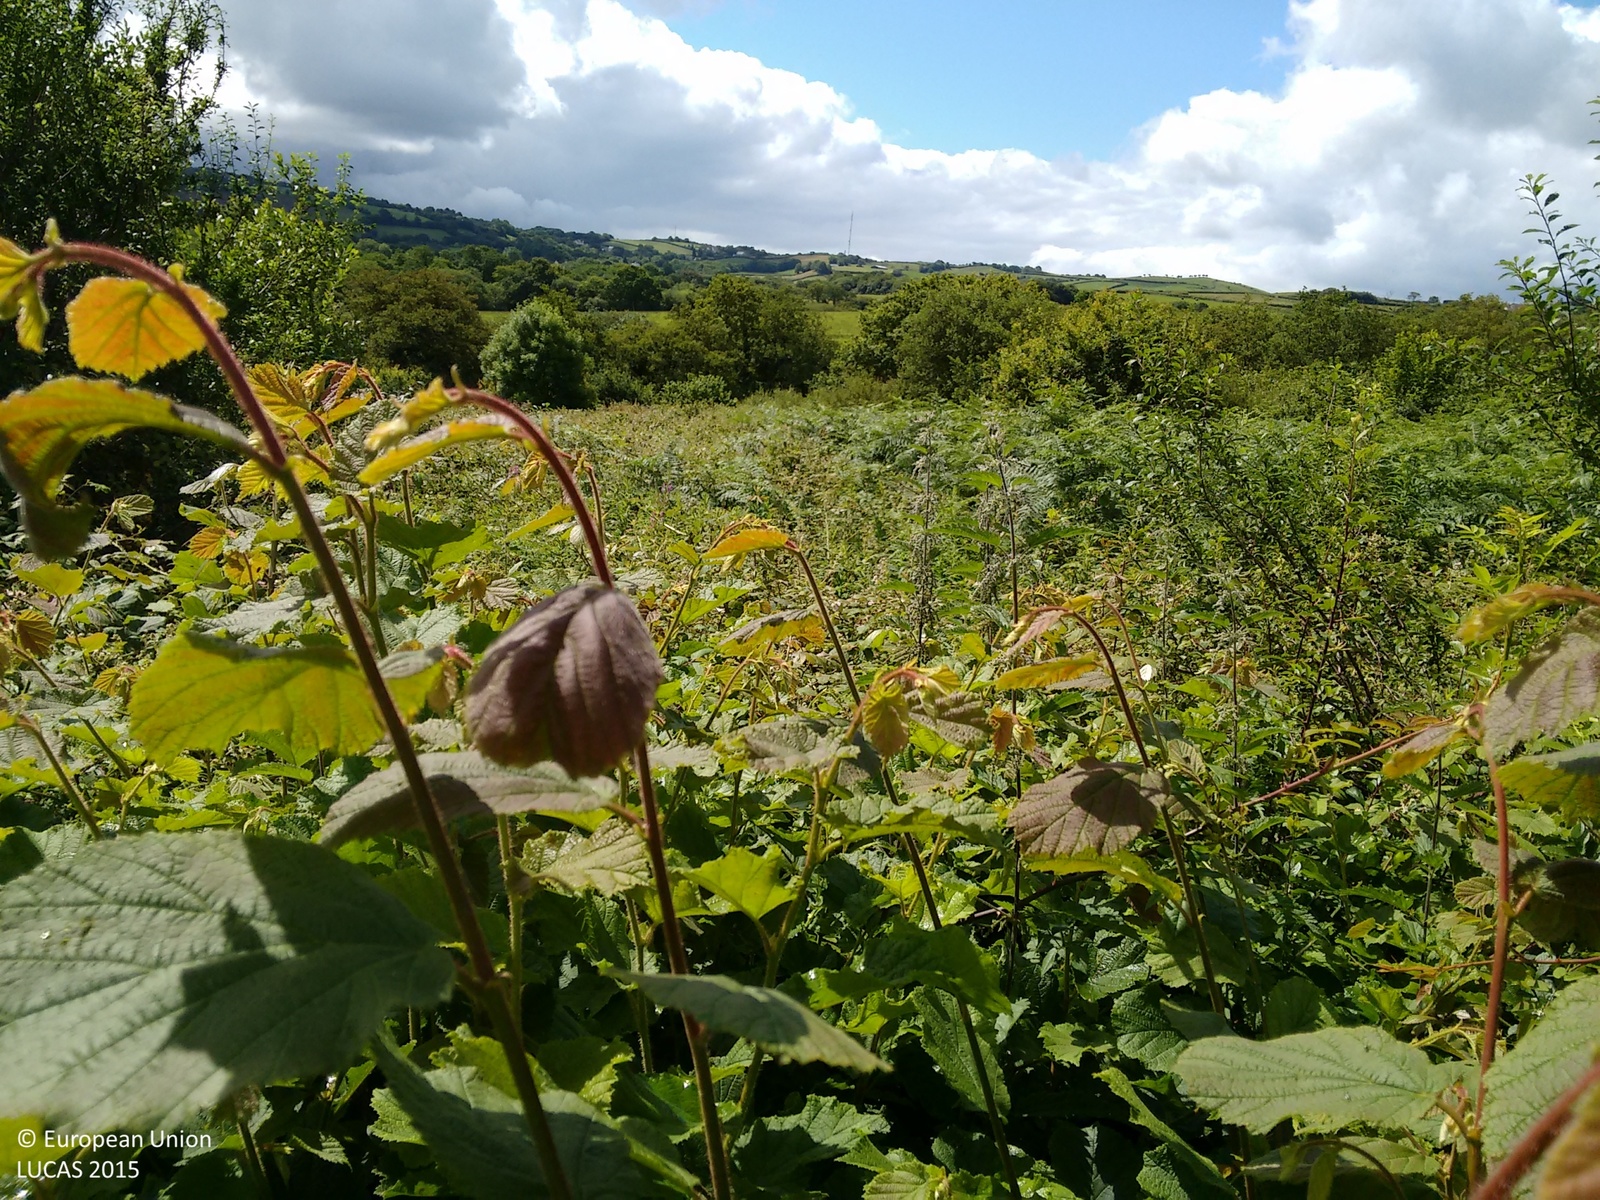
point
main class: Shrubland
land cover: Shrubland with sparse tree cover
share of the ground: > 75 %
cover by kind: shrubs 95 %, broadleaved forest trees 5 %
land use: Agriculture (excluding fallow land and kitchen gardens)
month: July
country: GB
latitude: 51.8472
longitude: -4.0458
